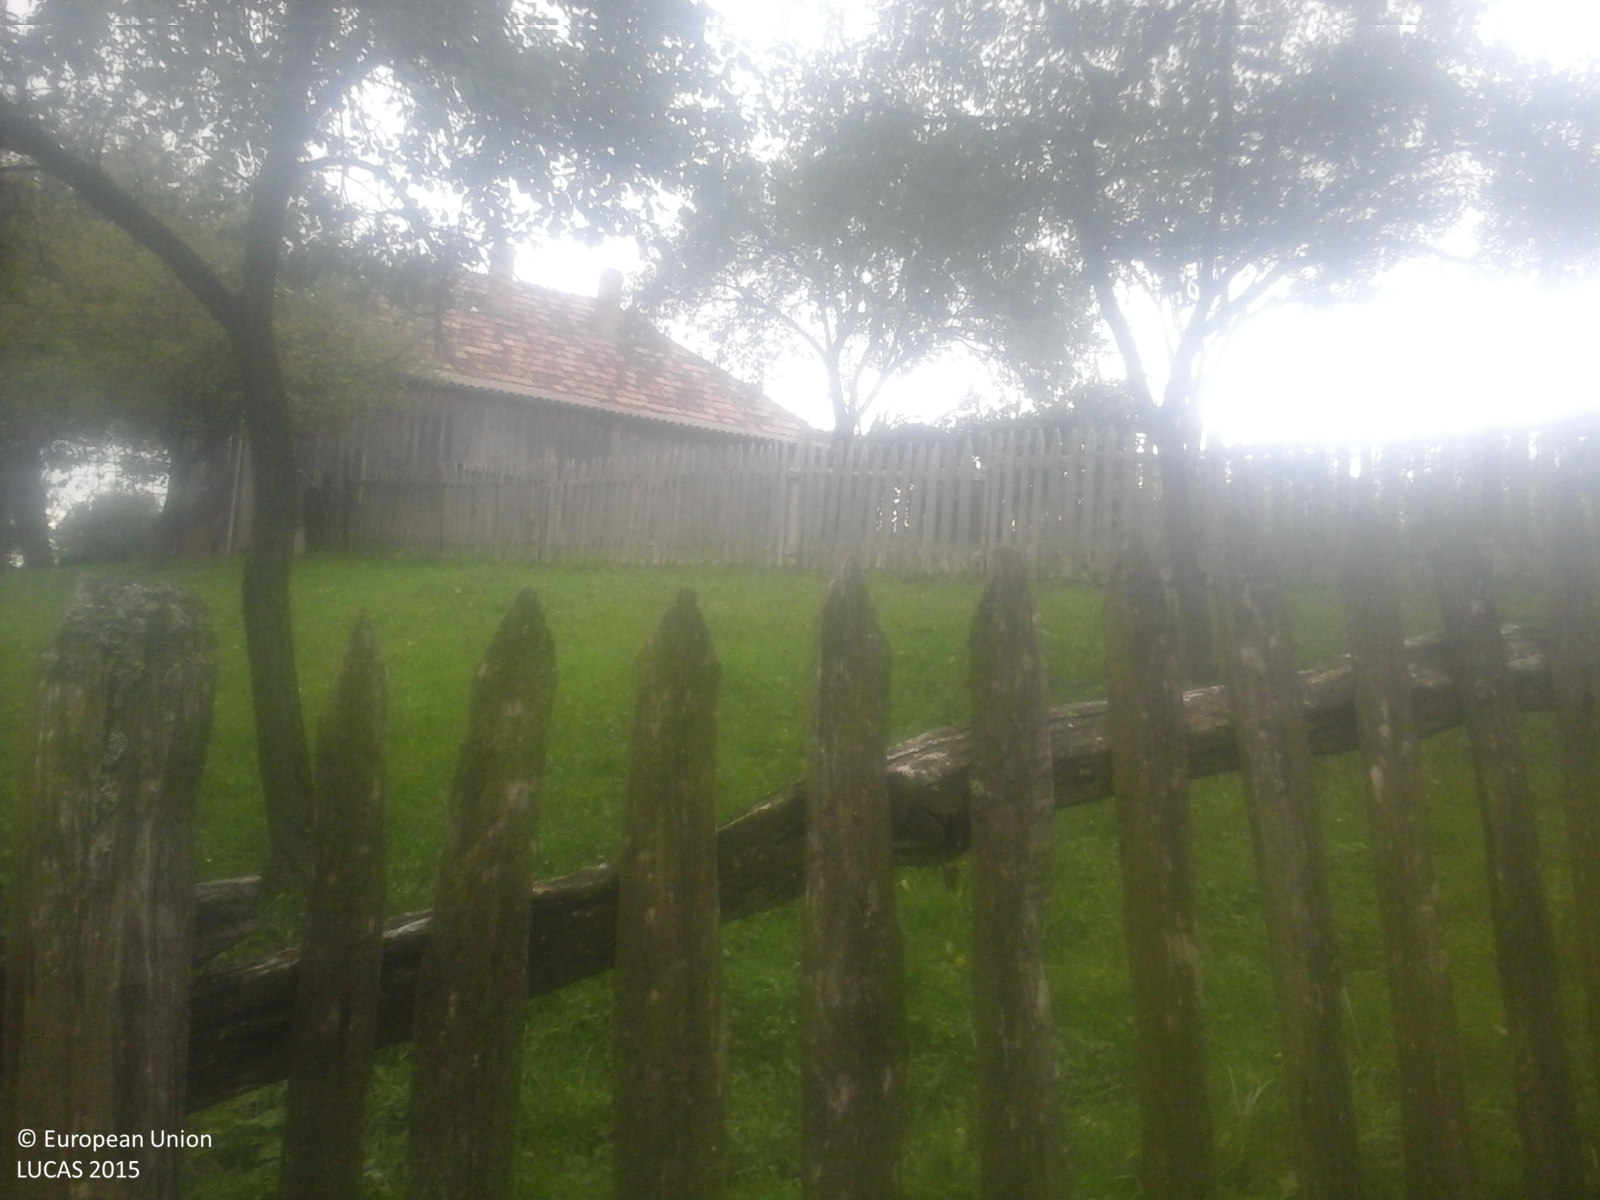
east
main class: Cropland
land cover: Apple fruit
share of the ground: 10 - 25 %
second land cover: Grassland without tree/shrub cover
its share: > 75 %
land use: Agriculture (excluding fallow land and kitchen gardens)
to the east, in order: Apple fruit; Grassland without tree/shrub cover; Permanent crops (only in case pi); Broadleaved woodland; Grassland without tree/shrub cover; Broadleaved woodland
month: September
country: RO
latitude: 45.8385
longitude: 23.4919
